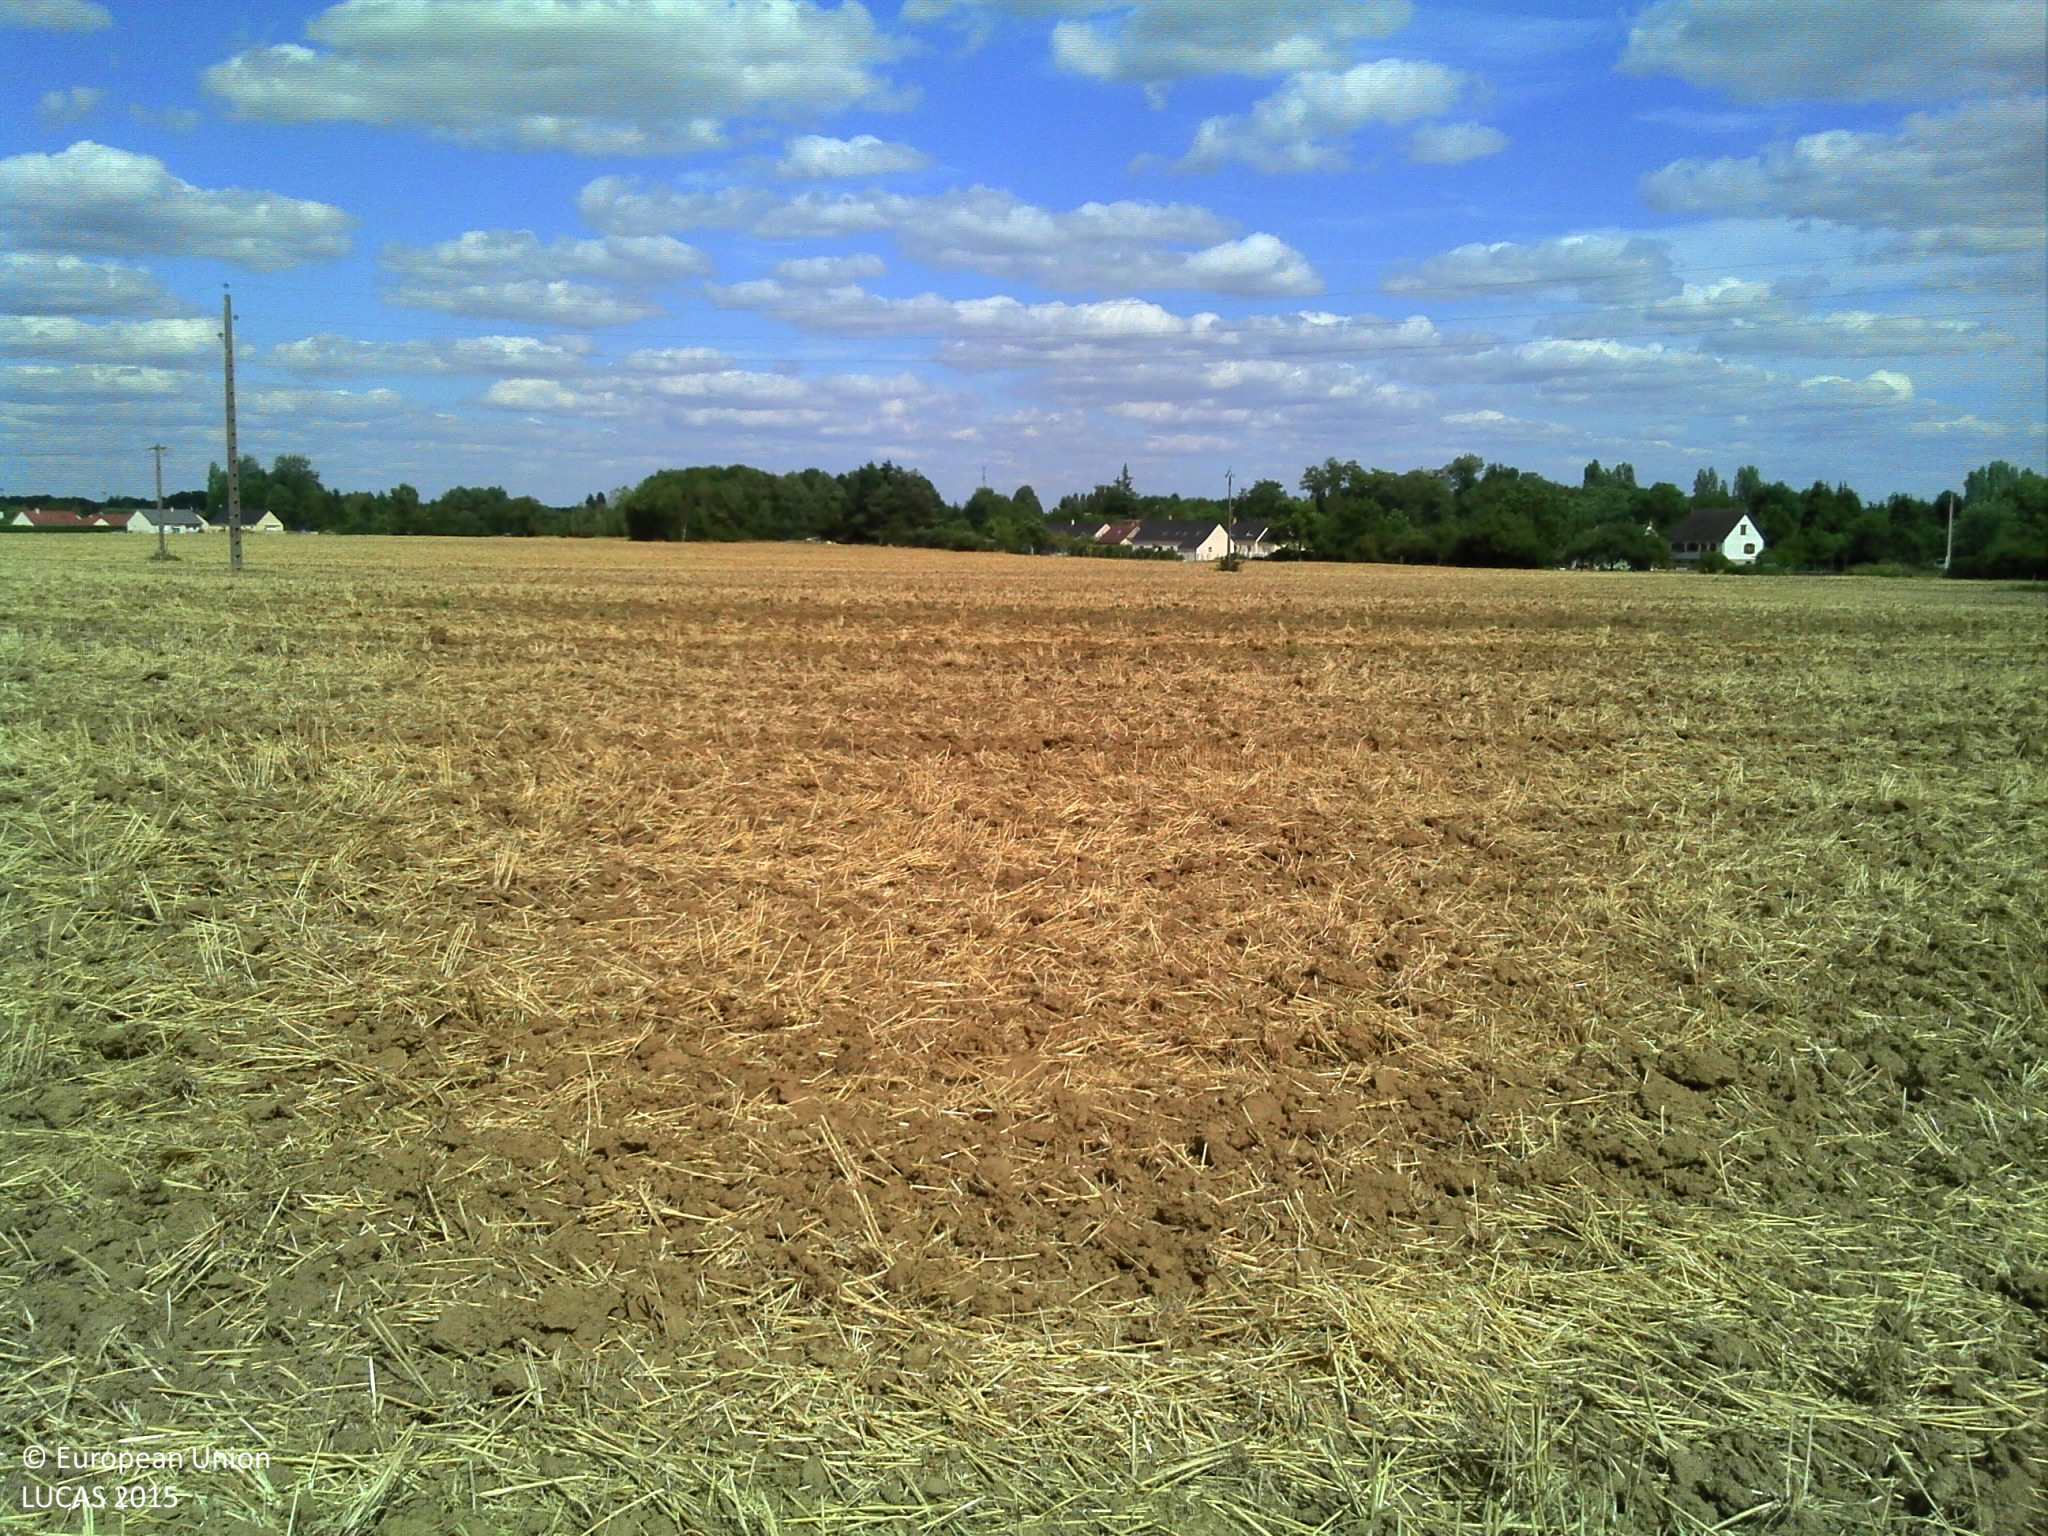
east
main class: Cropland
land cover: Common wheat
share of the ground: > 75 %
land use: Agriculture (excluding fallow land and kitchen gardens)
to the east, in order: Common wheat; Electric lines; Common wheat; Electric lines; Ditches and canals; Grass margins; Tracks; Common wheat
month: July
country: FR
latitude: 47.9199
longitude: 2.5910
